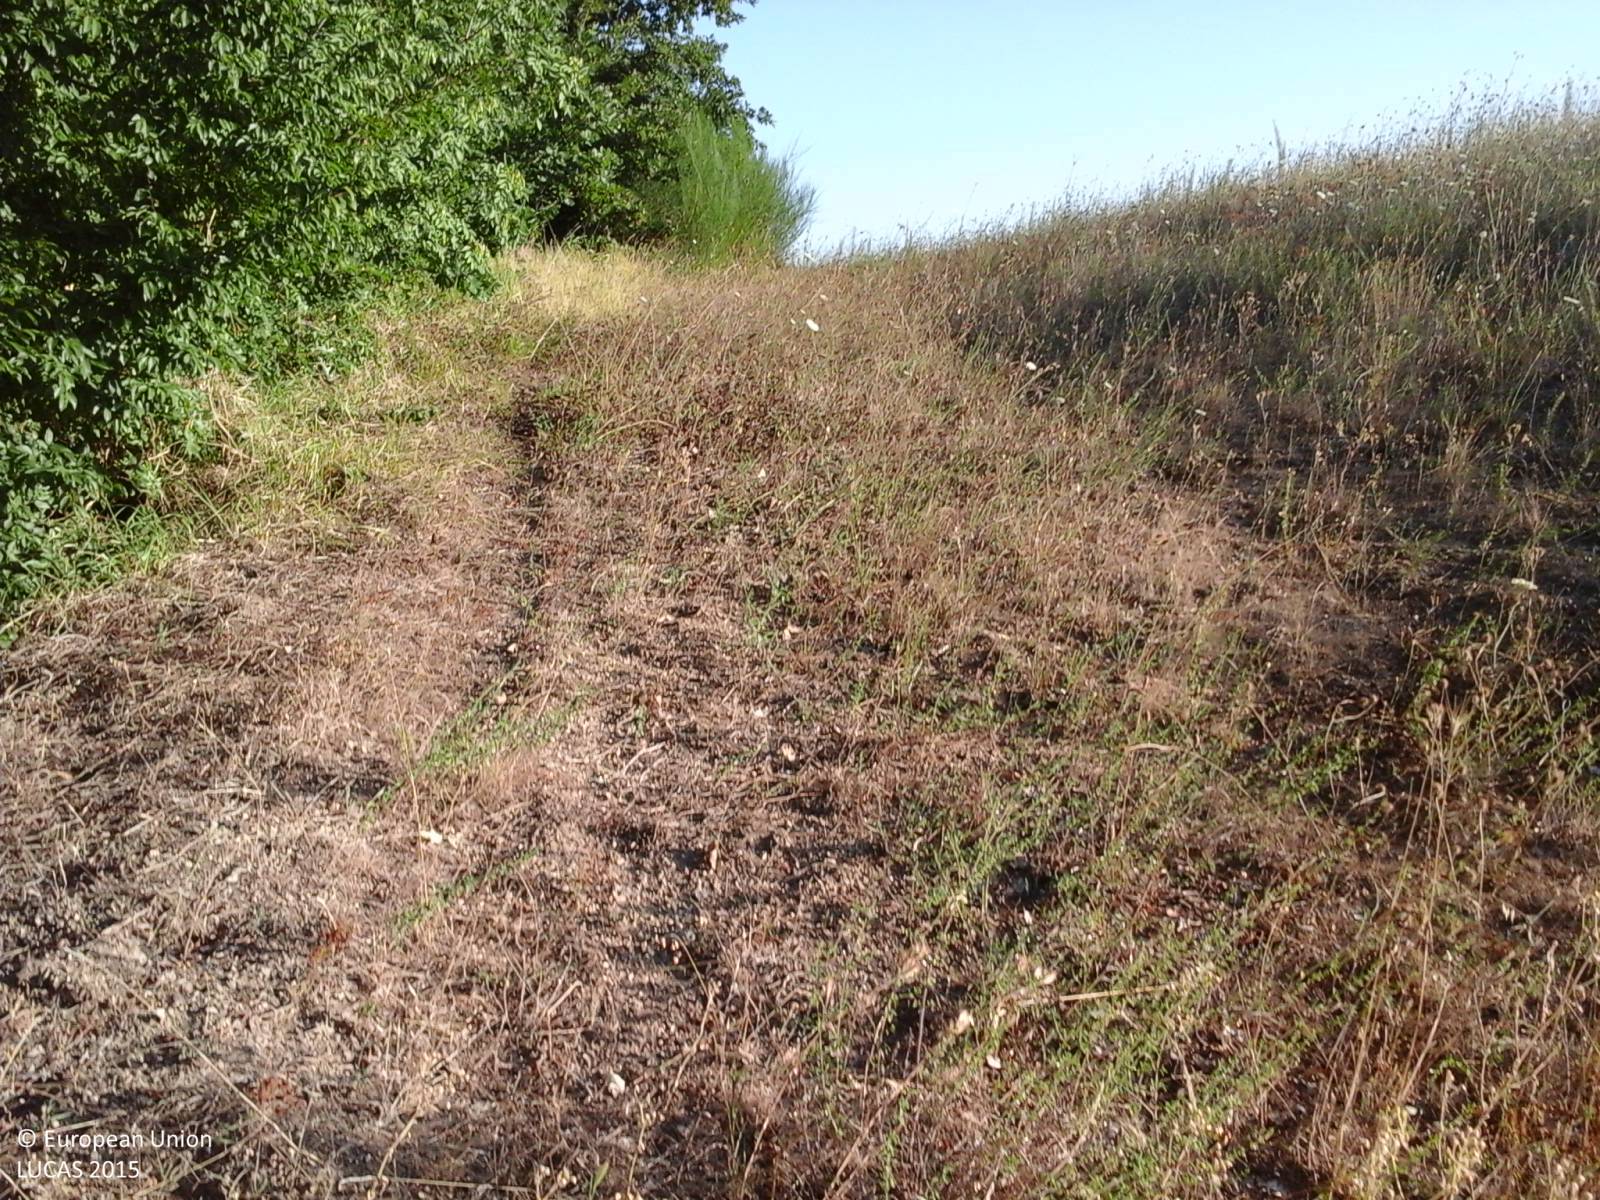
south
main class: Grassland
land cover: Grassland without tree/shrub cover
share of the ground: > 75 %
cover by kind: herbaceous plants 100 %
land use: Agriculture (excluding fallow land and kitchen gardens)
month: July
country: IT
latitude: 42.1877
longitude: 12.5701
